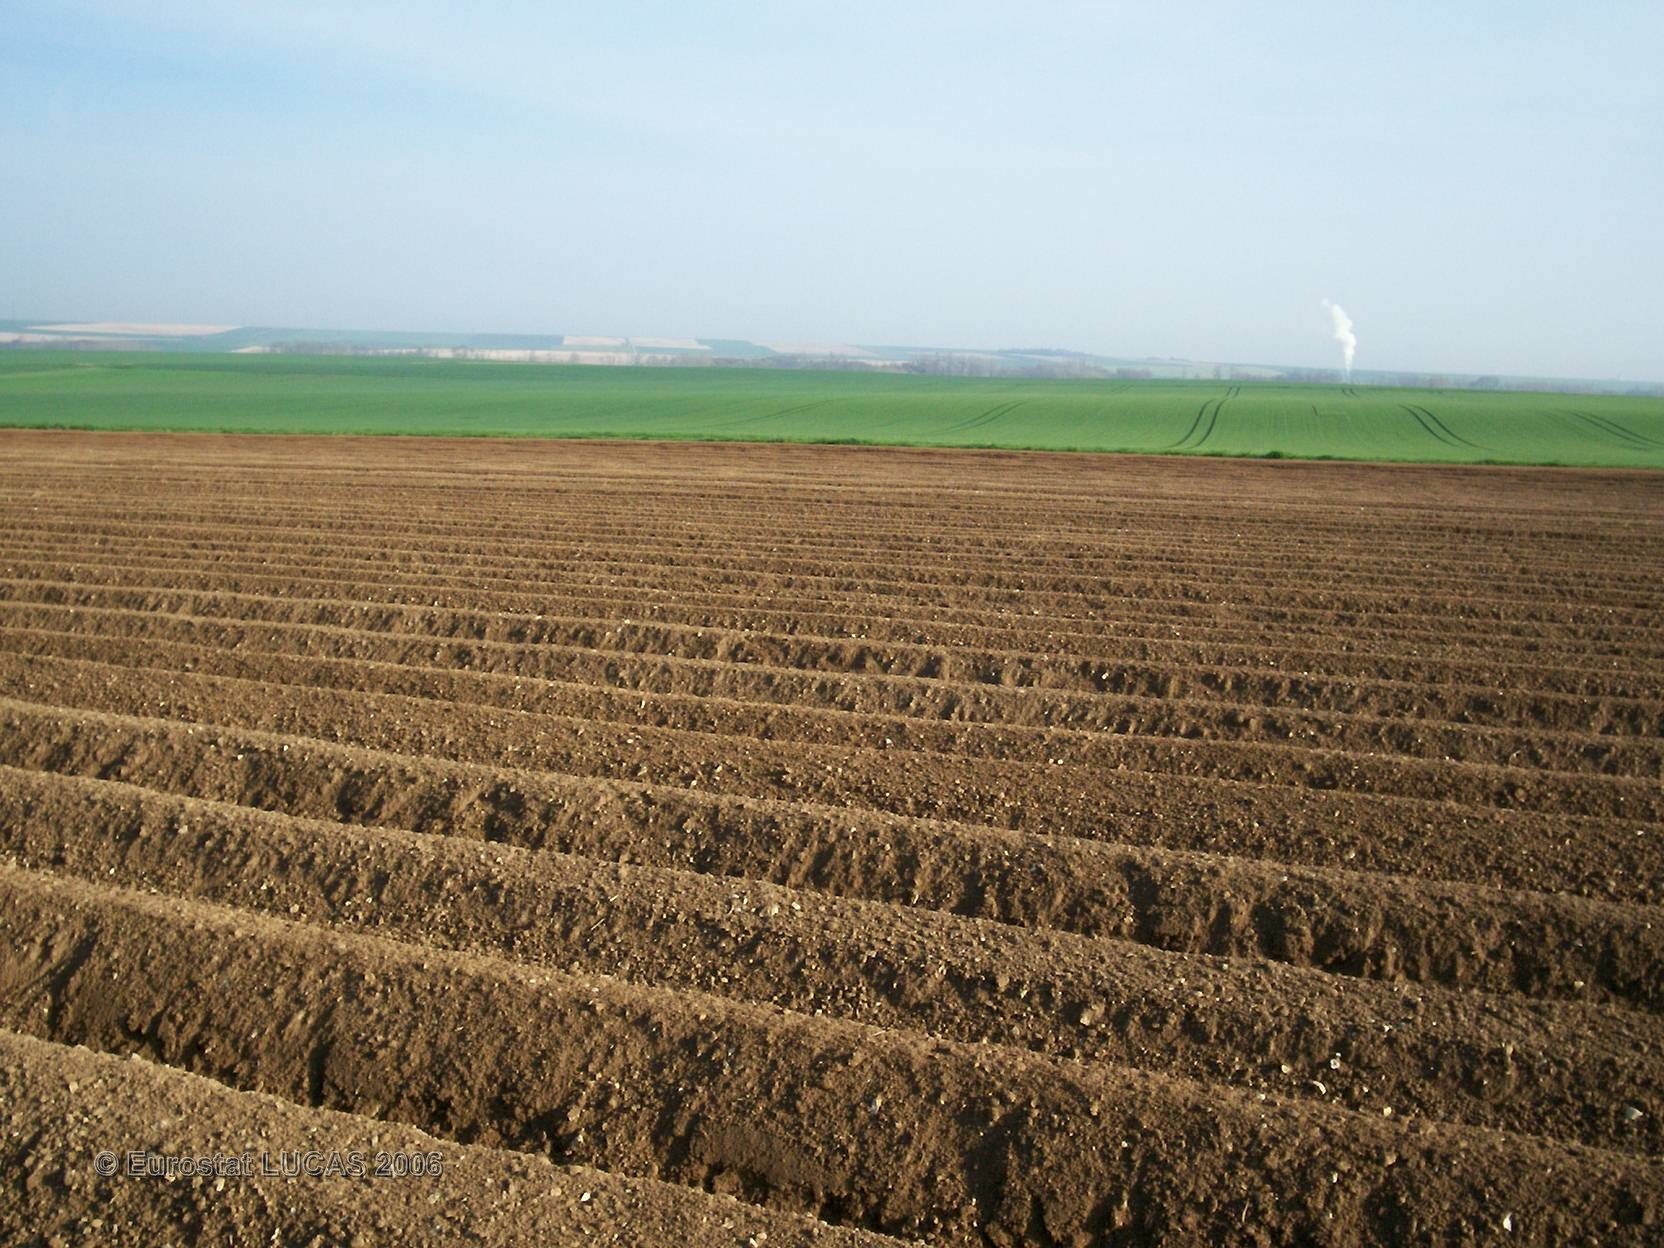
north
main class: Cropland
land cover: Potatoes
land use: Agriculture (excluding fallow land and kitchen gardens)
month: April
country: FR
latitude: 48.4620
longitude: 4.4389
